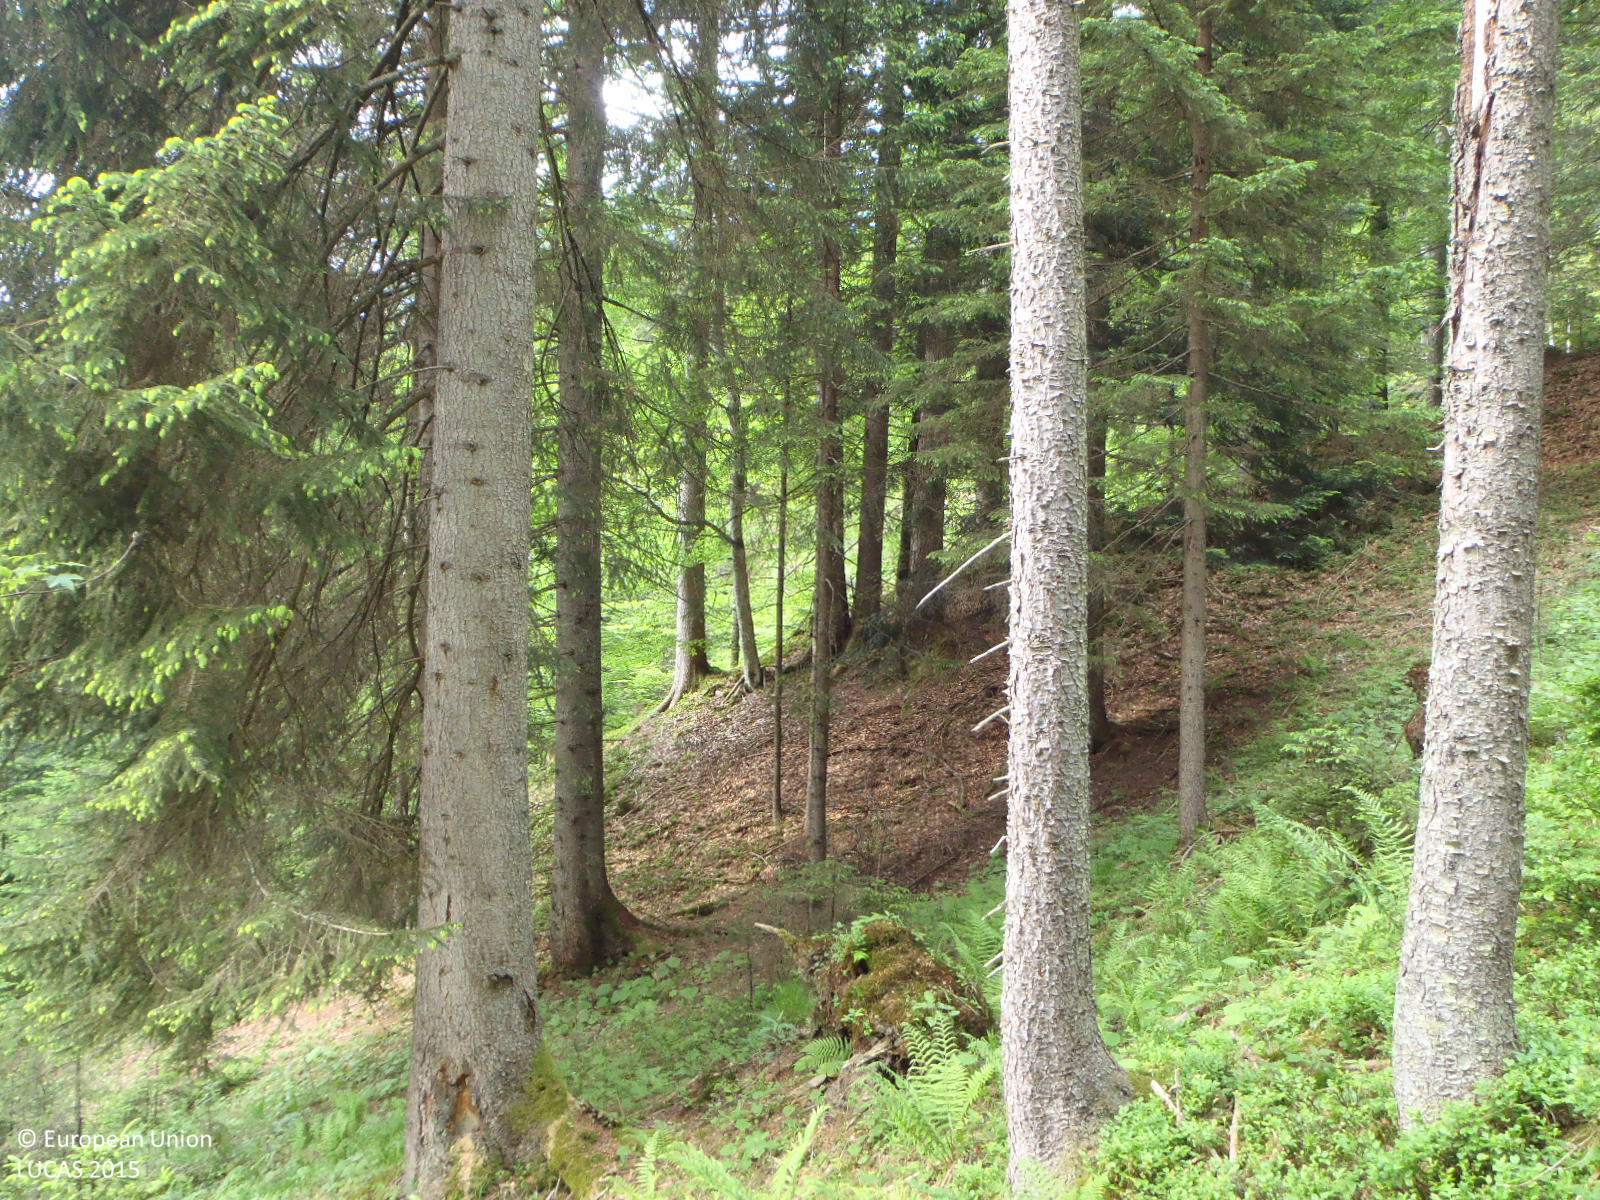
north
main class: Woodland
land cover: Spruce dominated coniferous woodland
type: alpine coniferous forest
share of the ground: > 75 %
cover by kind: coniferous forest trees 60 %, herbaceous plants 20 %, broadleaved forest trees 15 %, shrubs 5 %
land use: Forestry
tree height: > 5 m
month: June
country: AT
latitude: 47.5108
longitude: 12.5079
